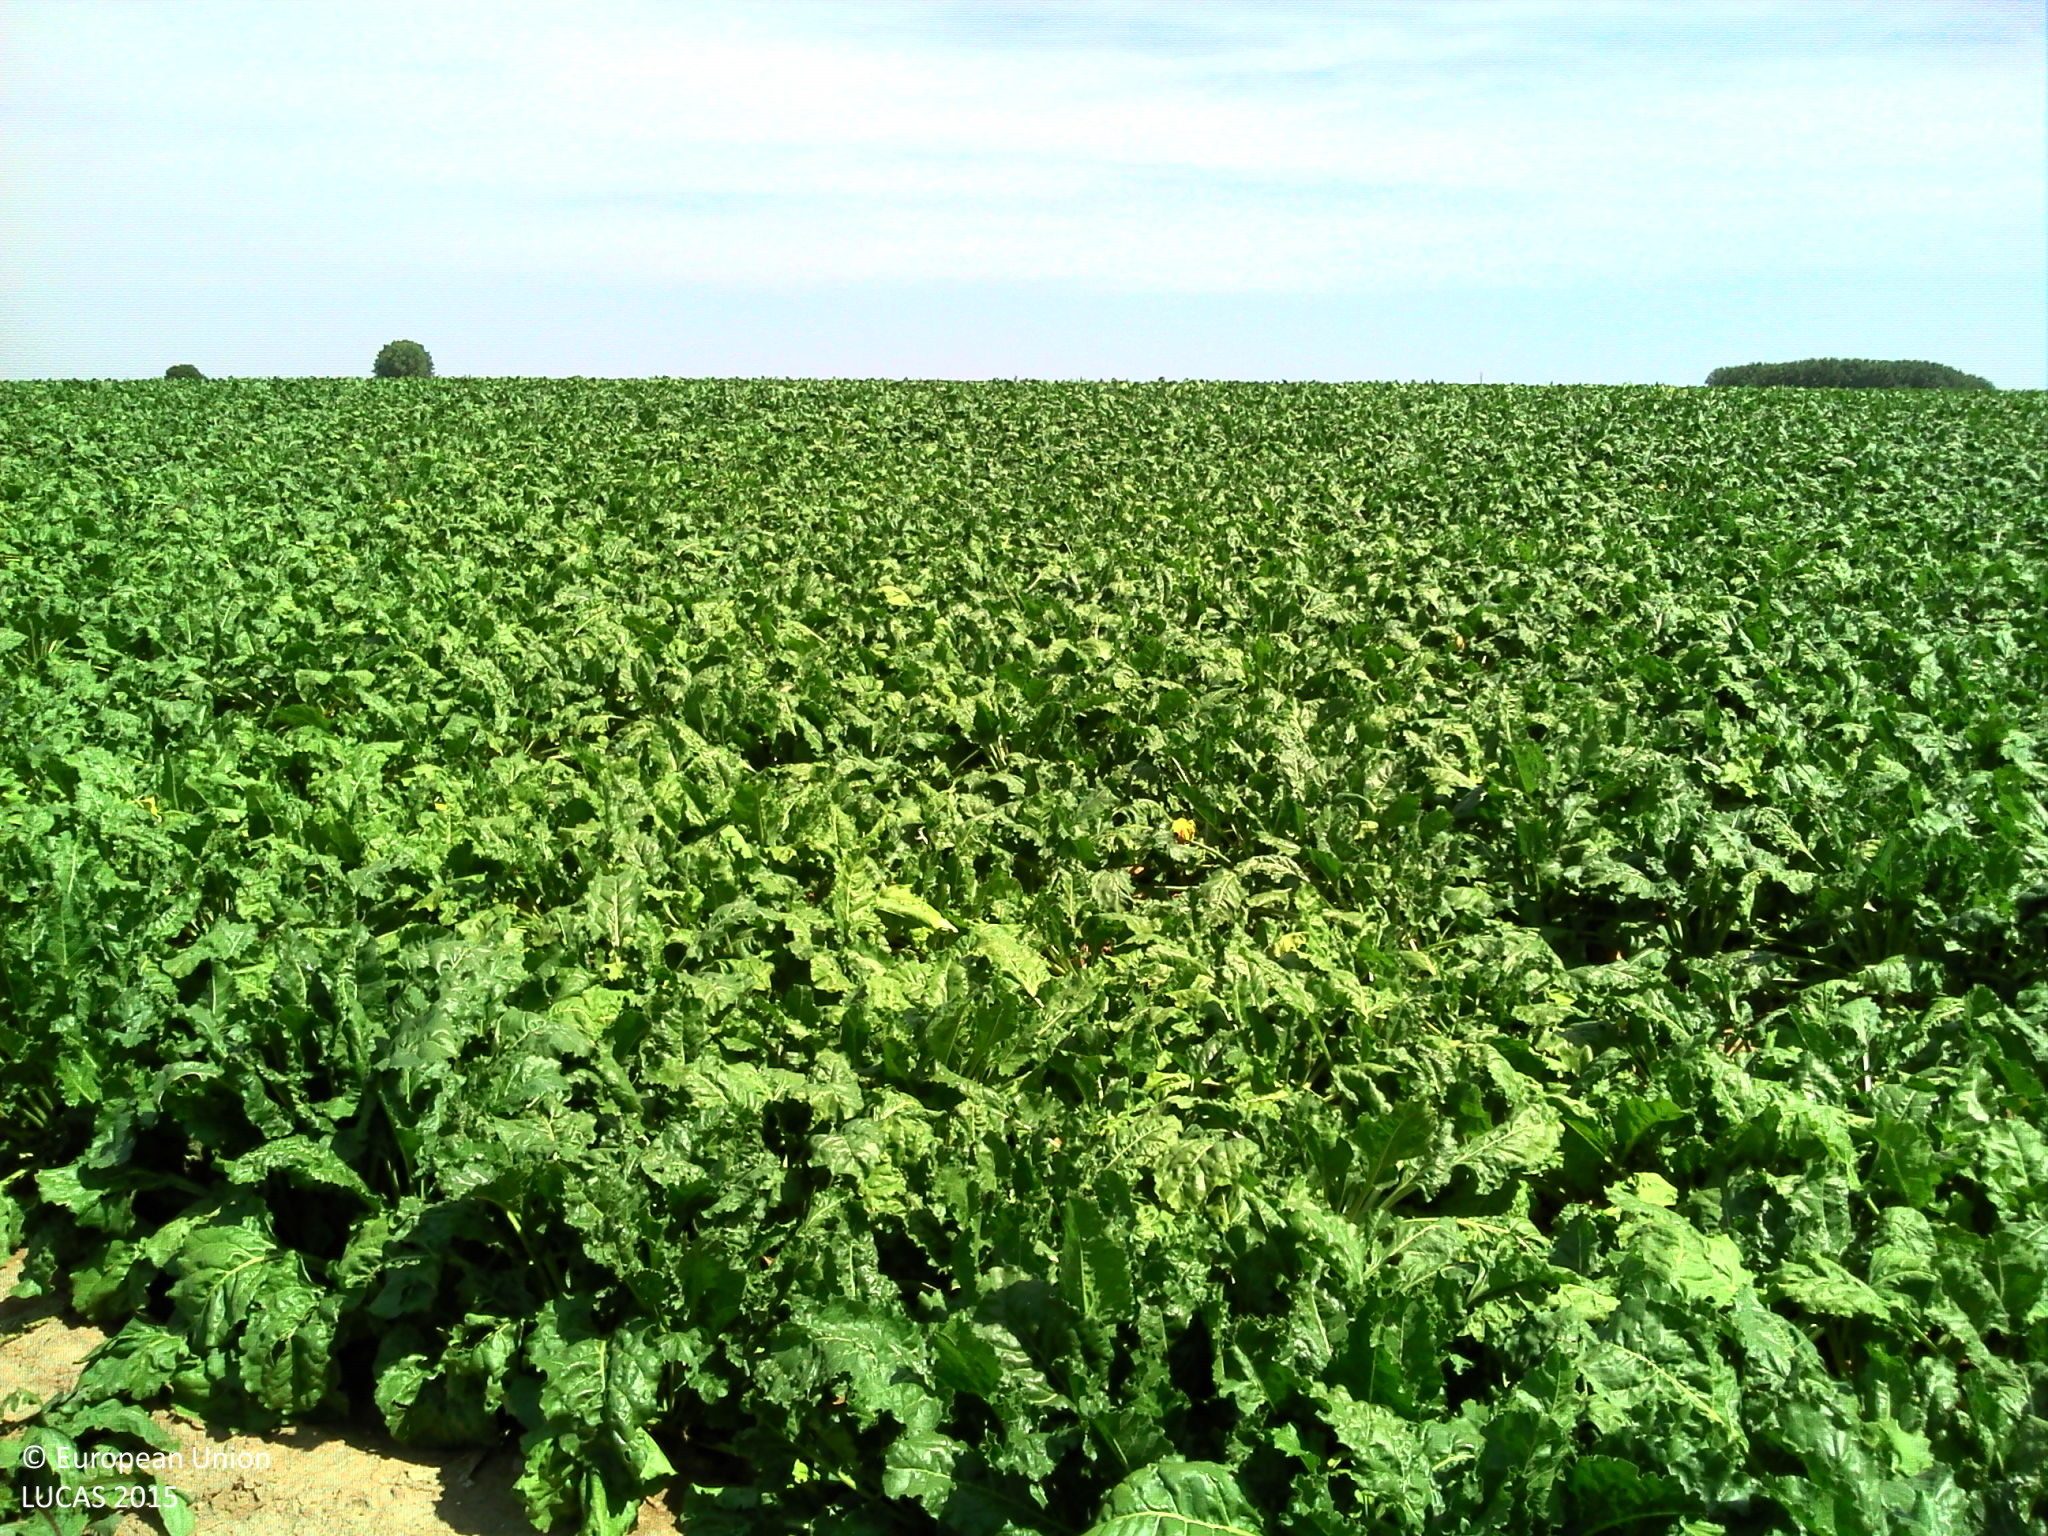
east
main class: Cropland
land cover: Other root crops
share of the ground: > 75 %
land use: Agriculture (excluding fallow land and kitchen gardens)
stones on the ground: < 10 %
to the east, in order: Other root crops; Common wheat
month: August
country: FR
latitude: 50.2333
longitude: 3.1917
